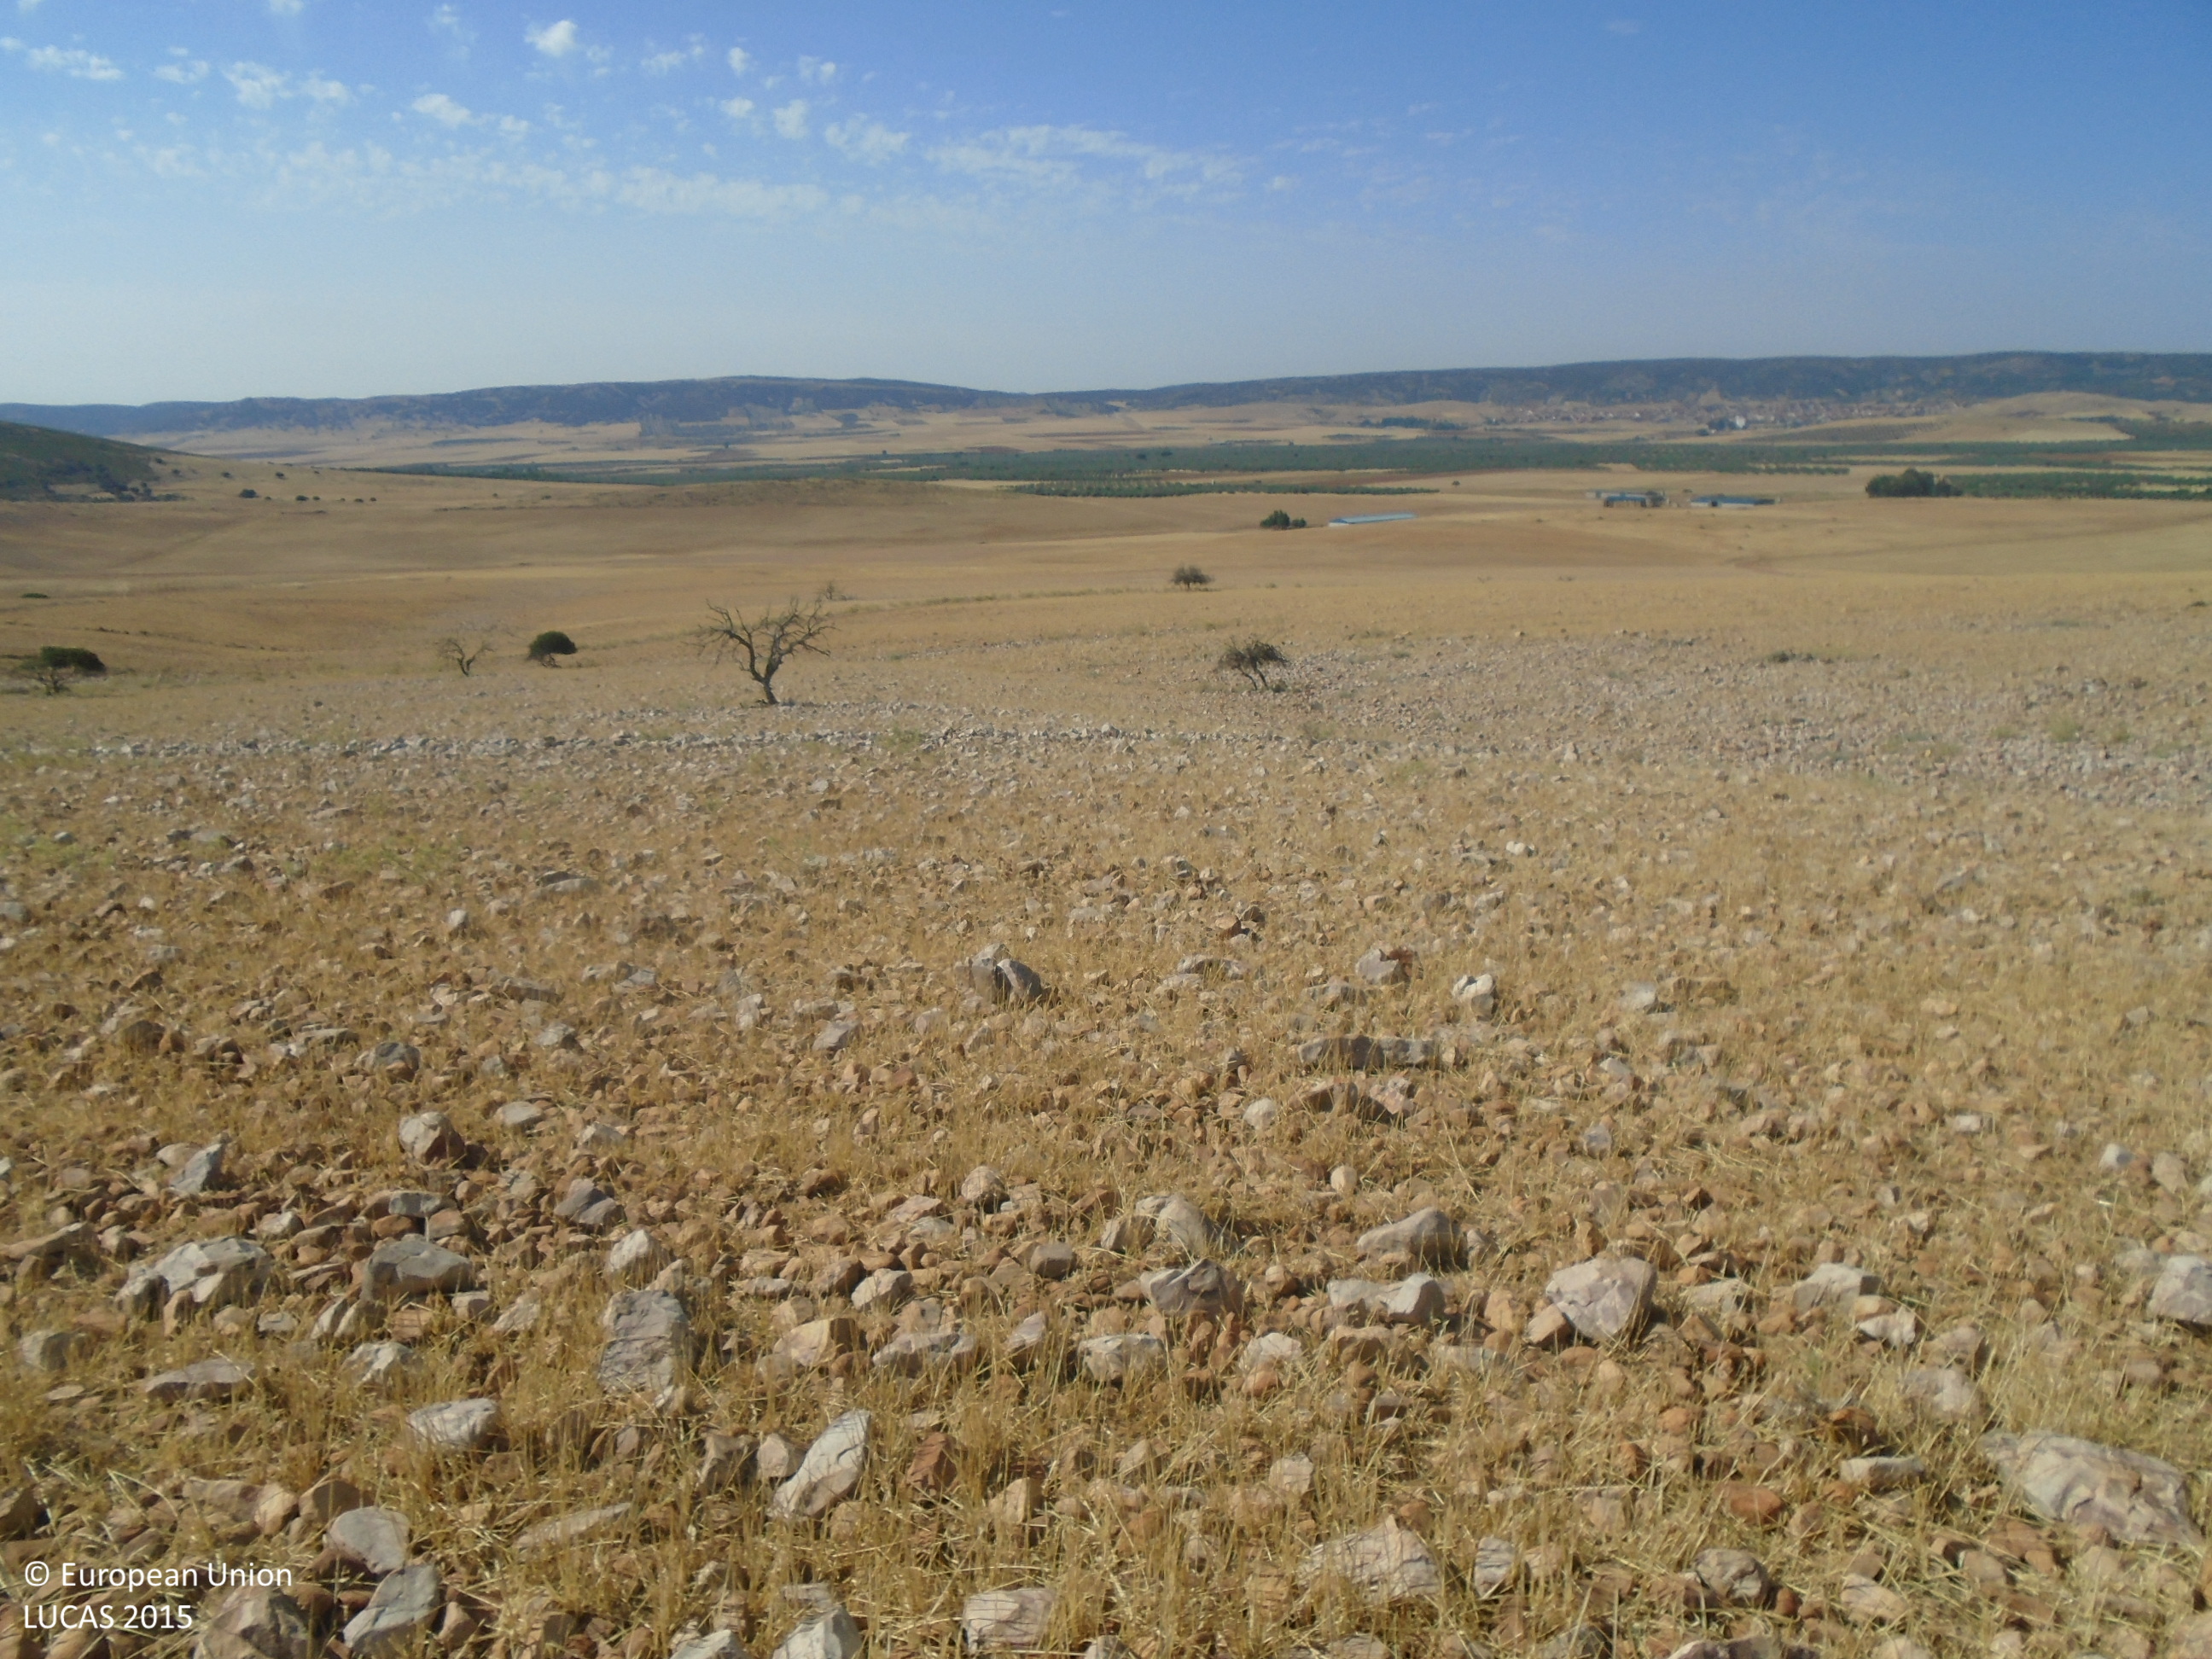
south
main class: Grassland
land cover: Spontaneously vegetated surfaces
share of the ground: 50 - 75 %
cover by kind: consolidated bare surface 70 %, herbaceous plants 30 %
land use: Fallow land
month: July
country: ES
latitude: 39.2006
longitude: -4.1418
